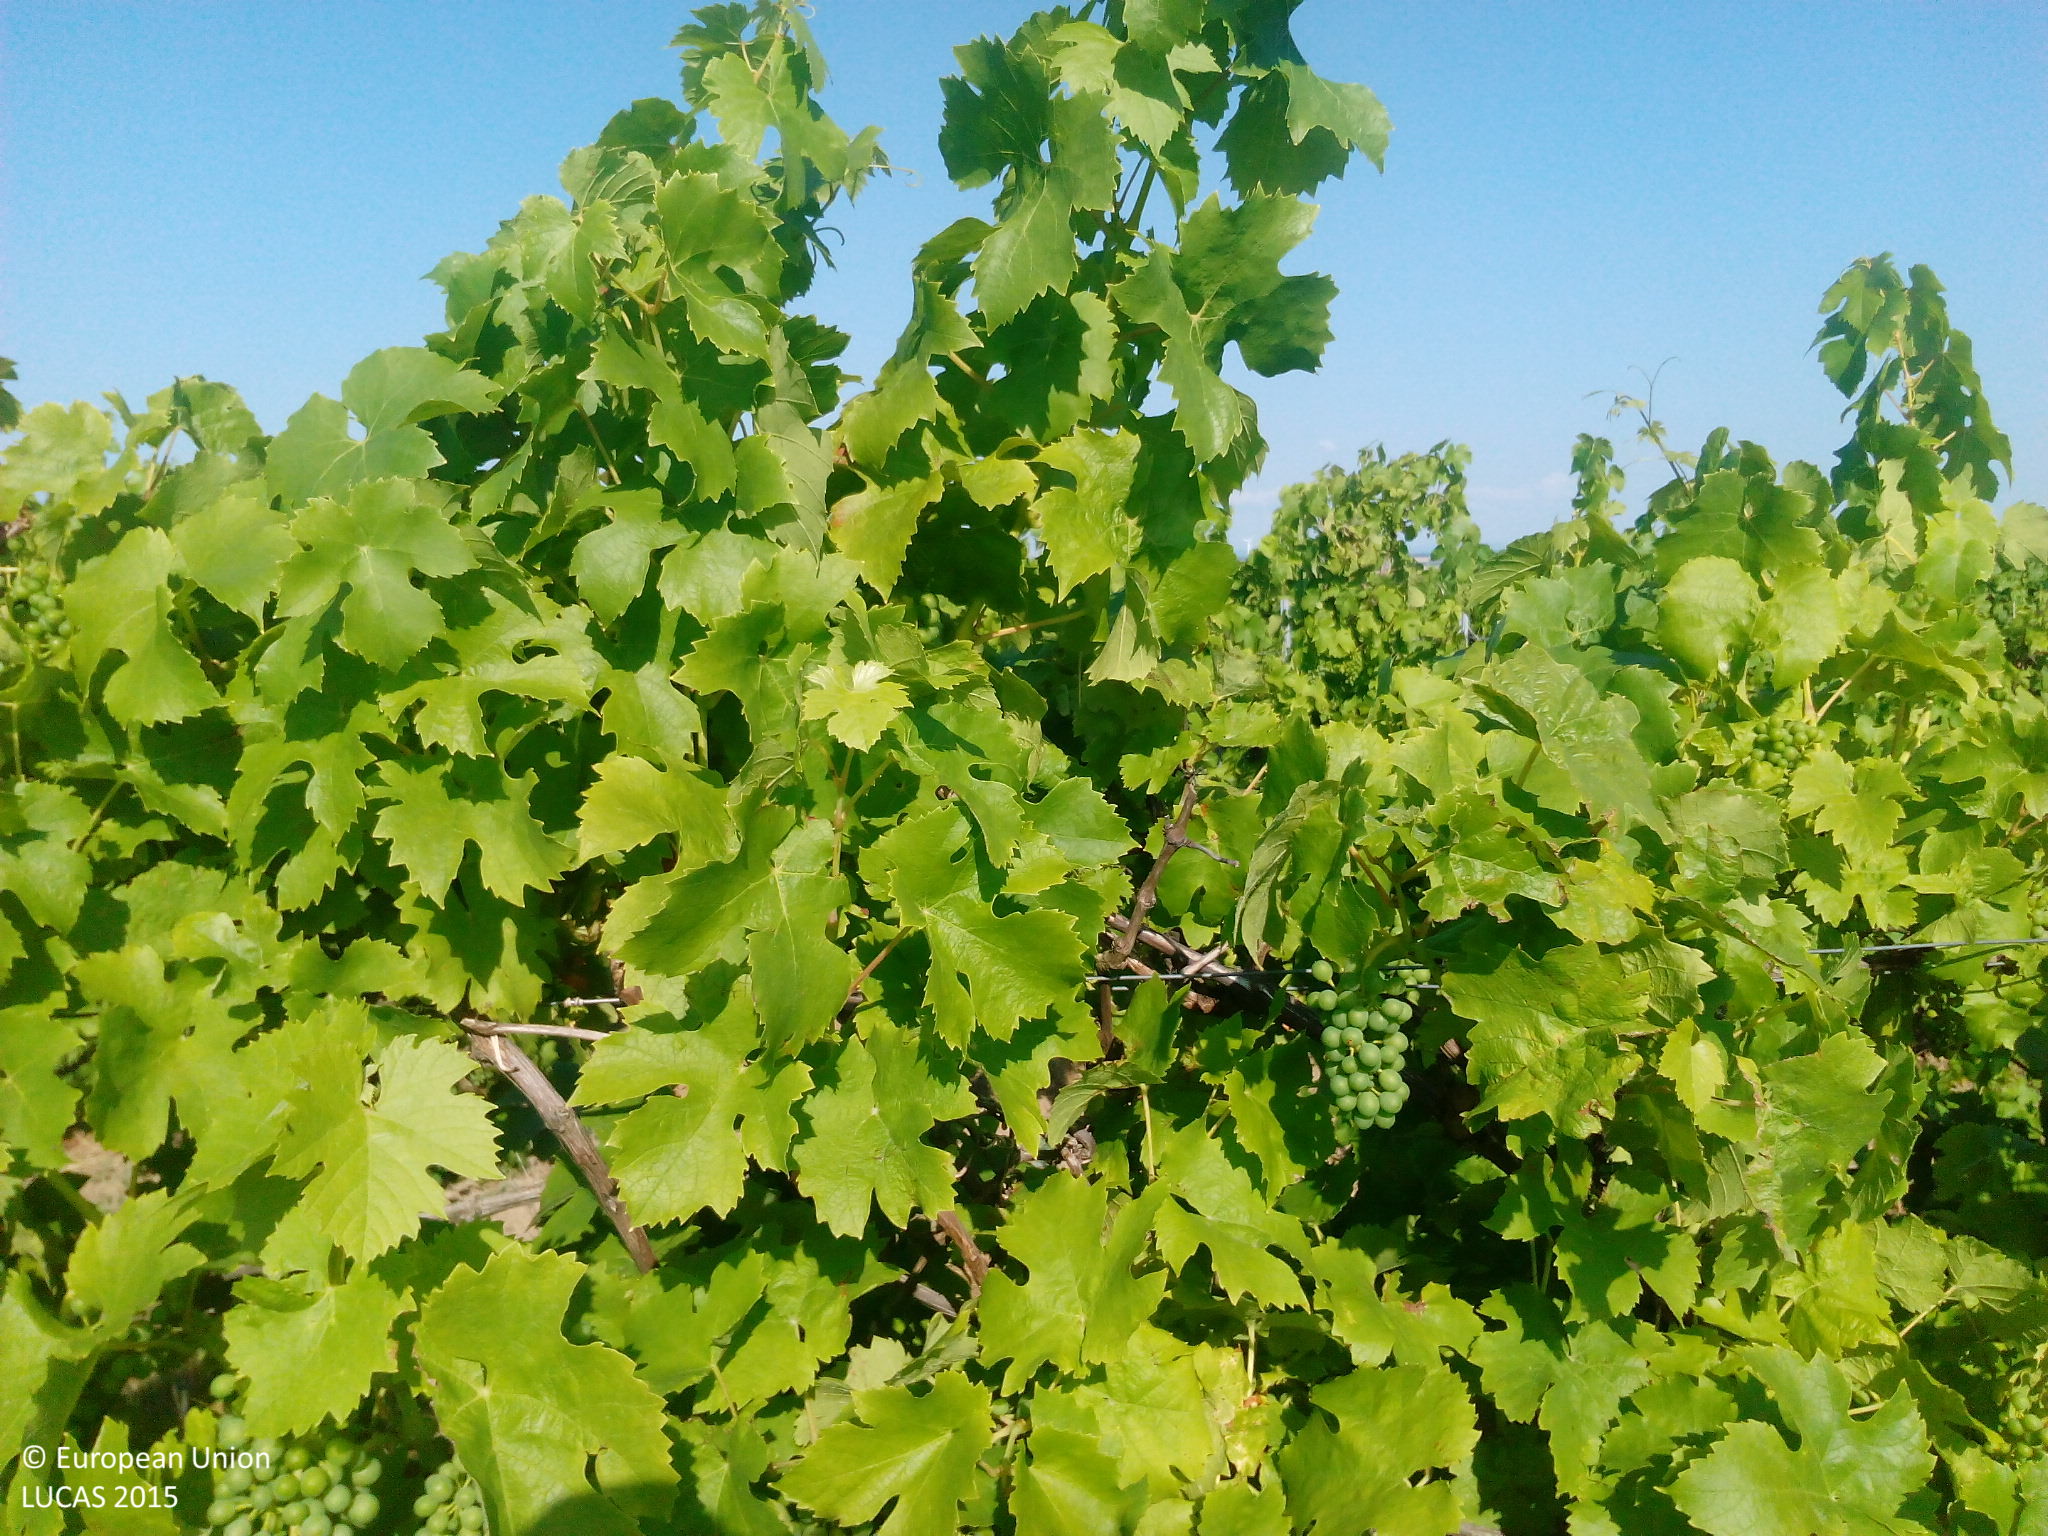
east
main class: Cropland
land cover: Vineyards
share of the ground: > 75 %
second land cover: Grassland without tree/shrub cover
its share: 50 - 75 %
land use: Agriculture (excluding fallow land and kitchen gardens)
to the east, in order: Vineyards; Grassland without tree/shrub cover; Grass margins; Tracks; Grass margins; Vineyards
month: July
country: DE
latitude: 49.8275
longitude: 8.1516
